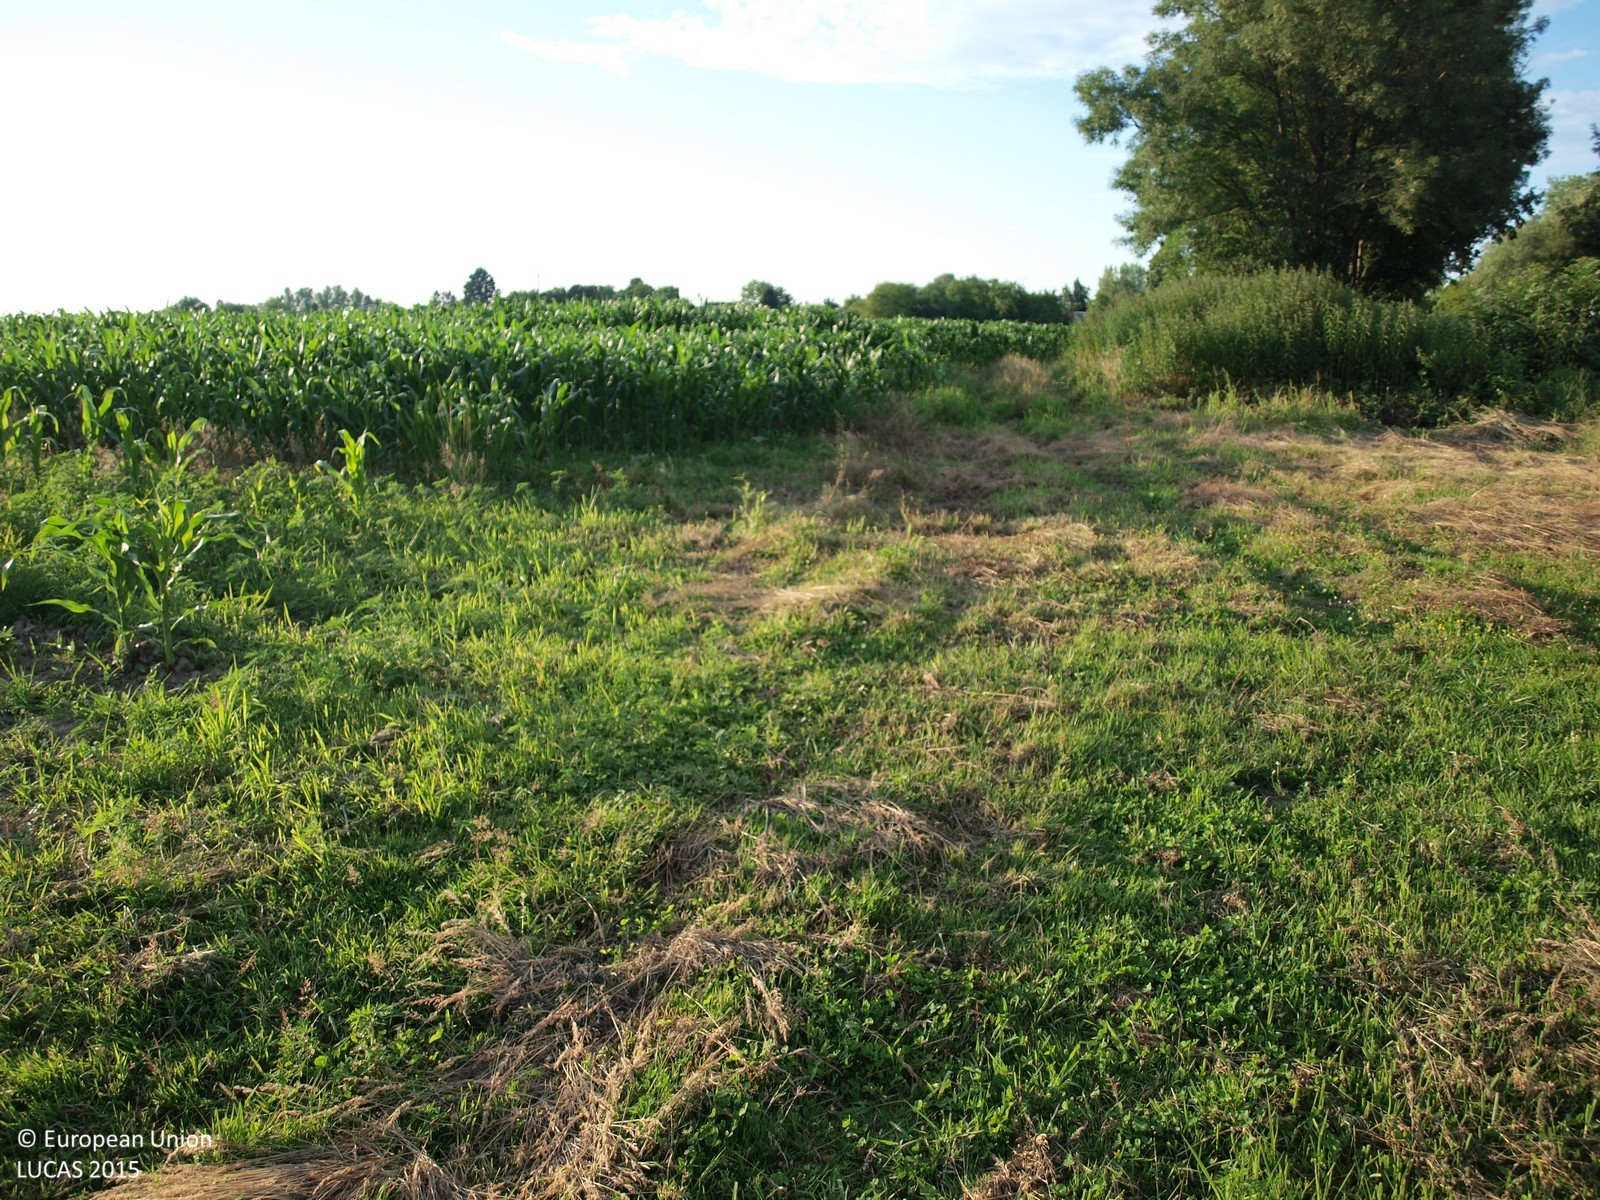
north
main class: Grassland
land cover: Grassland without tree/shrub cover
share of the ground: > 75 %
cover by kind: herbaceous plants 100 %
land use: Agriculture (excluding fallow land and kitchen gardens)
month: June
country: HR
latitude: 46.2523
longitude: 16.6553
